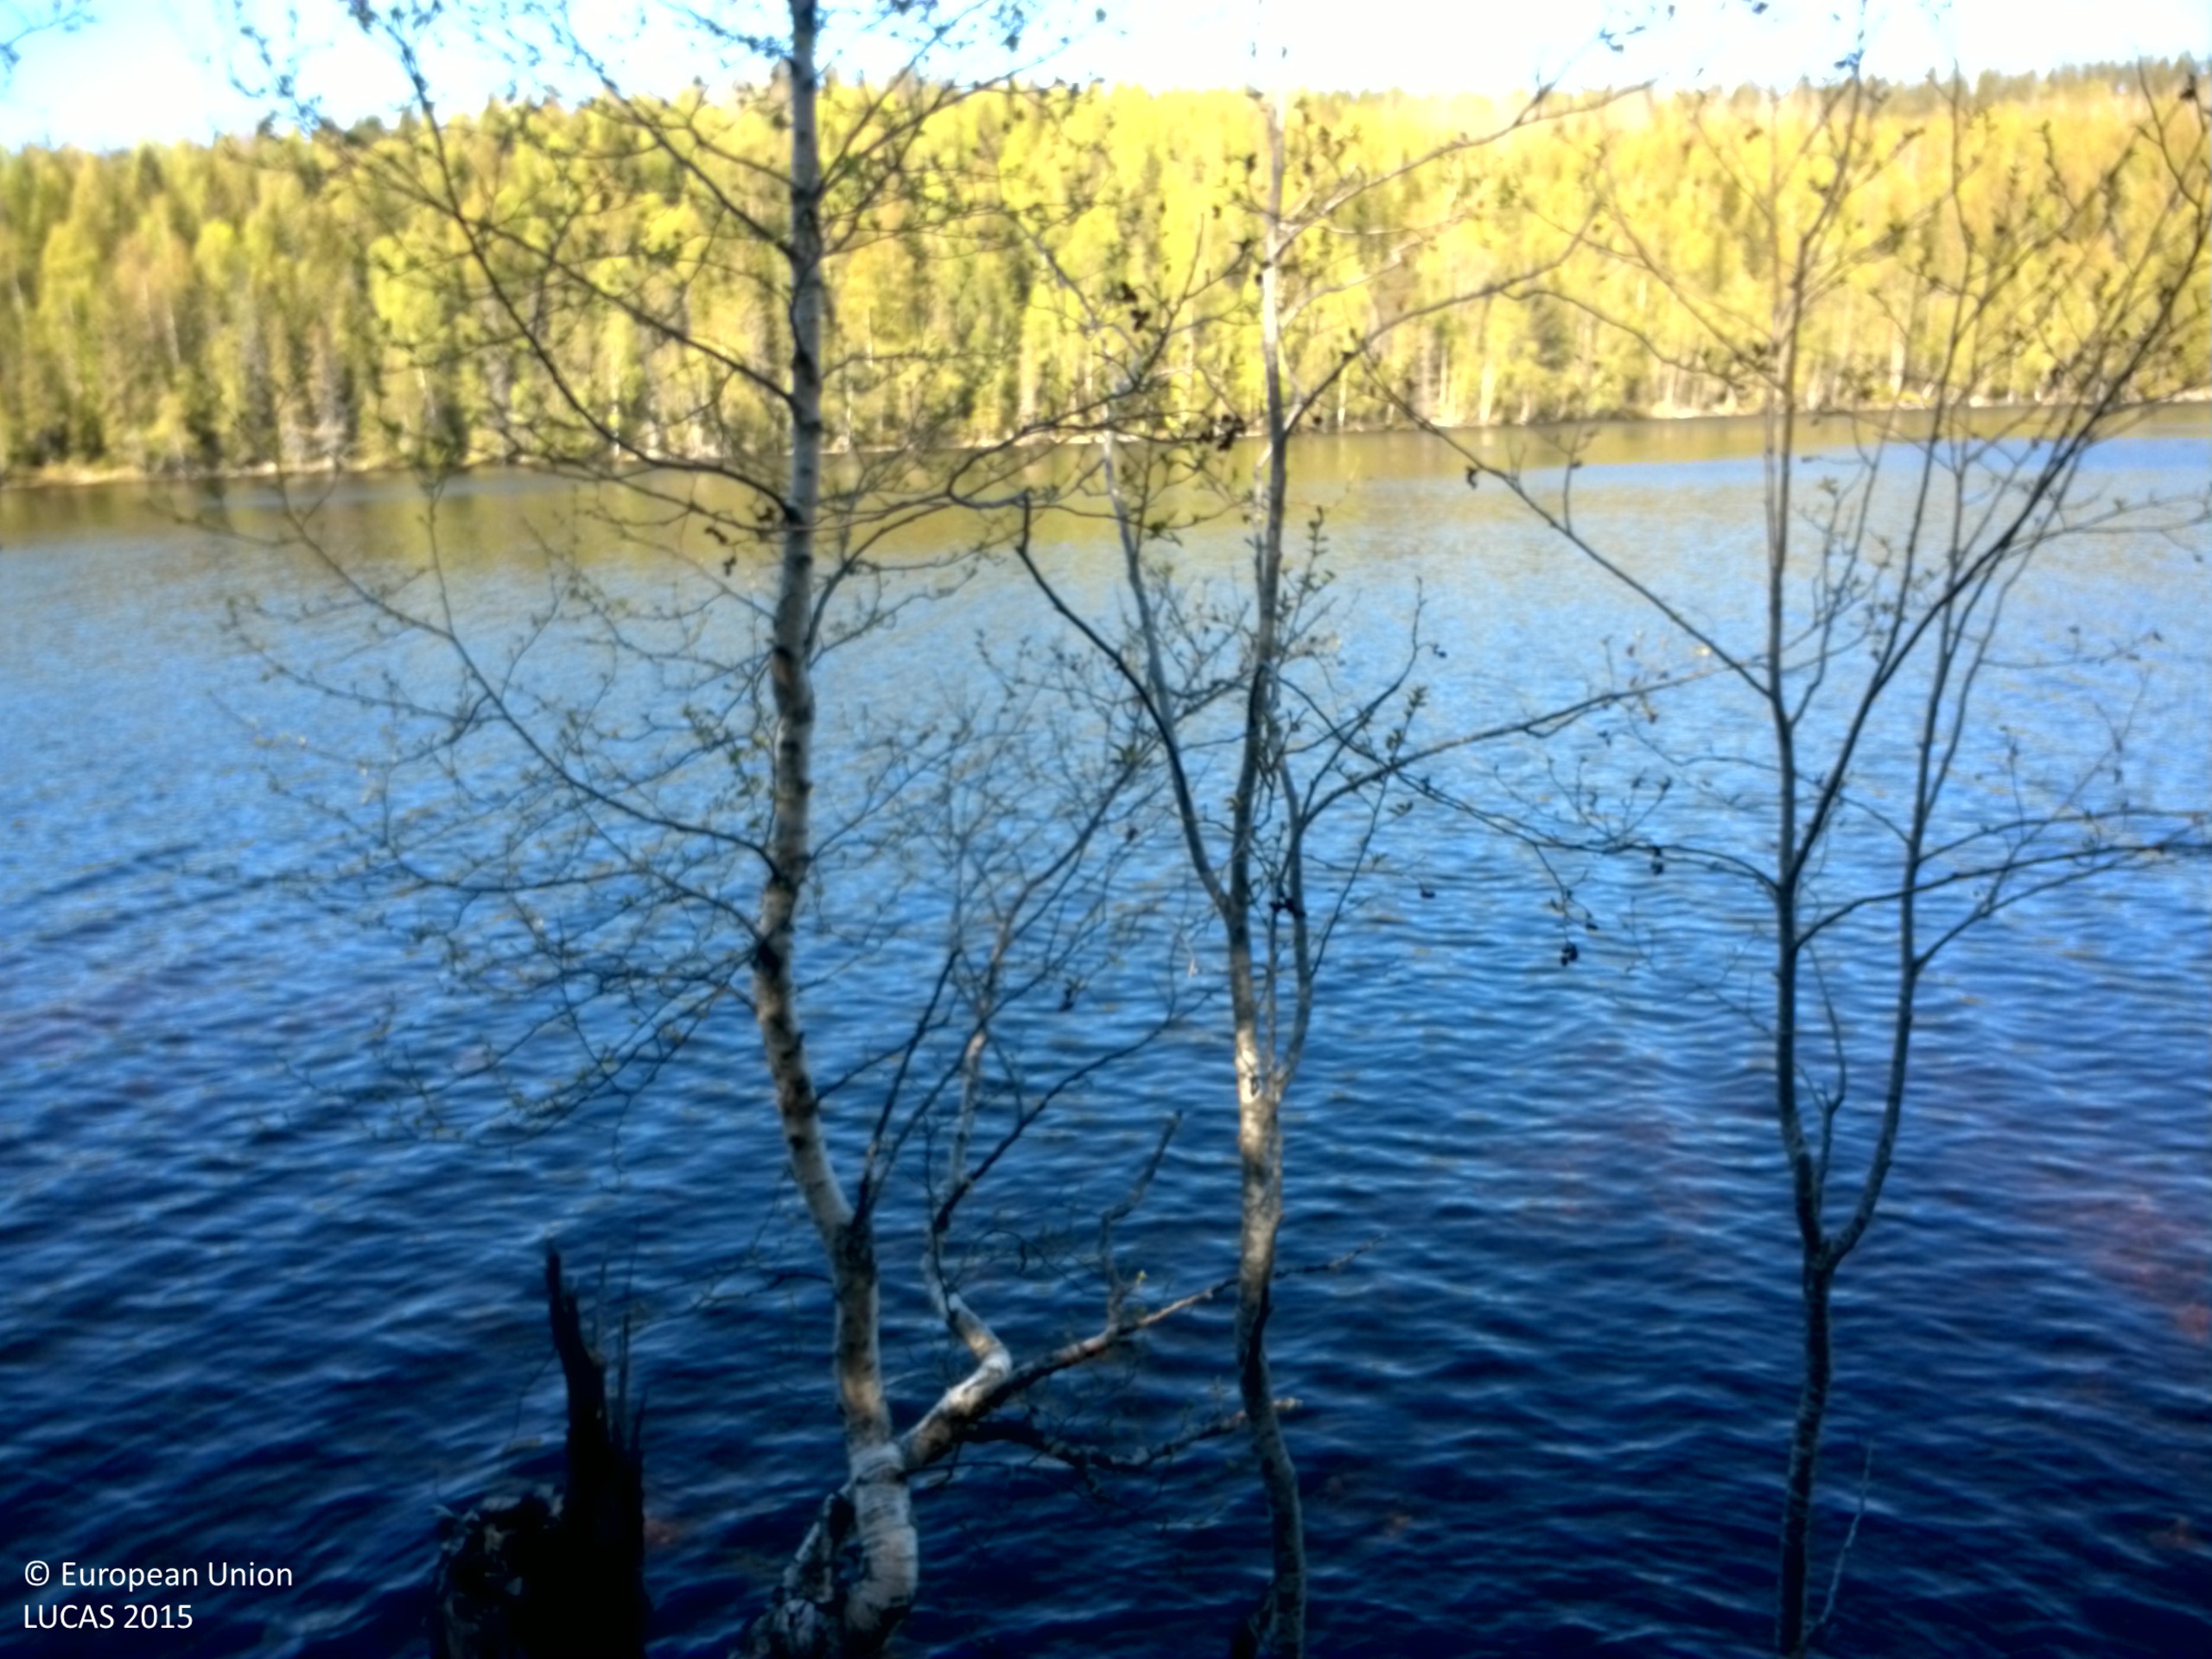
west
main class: Woodland
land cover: Pine dominated mixed woodland
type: boreal forest
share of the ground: > 75 %
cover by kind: coniferous forest trees 60 %, broadleaved forest trees 25 %, shrubs 15 %
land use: Residential
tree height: > 5 m
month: May
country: SE
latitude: 63.0352
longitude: 17.9837
